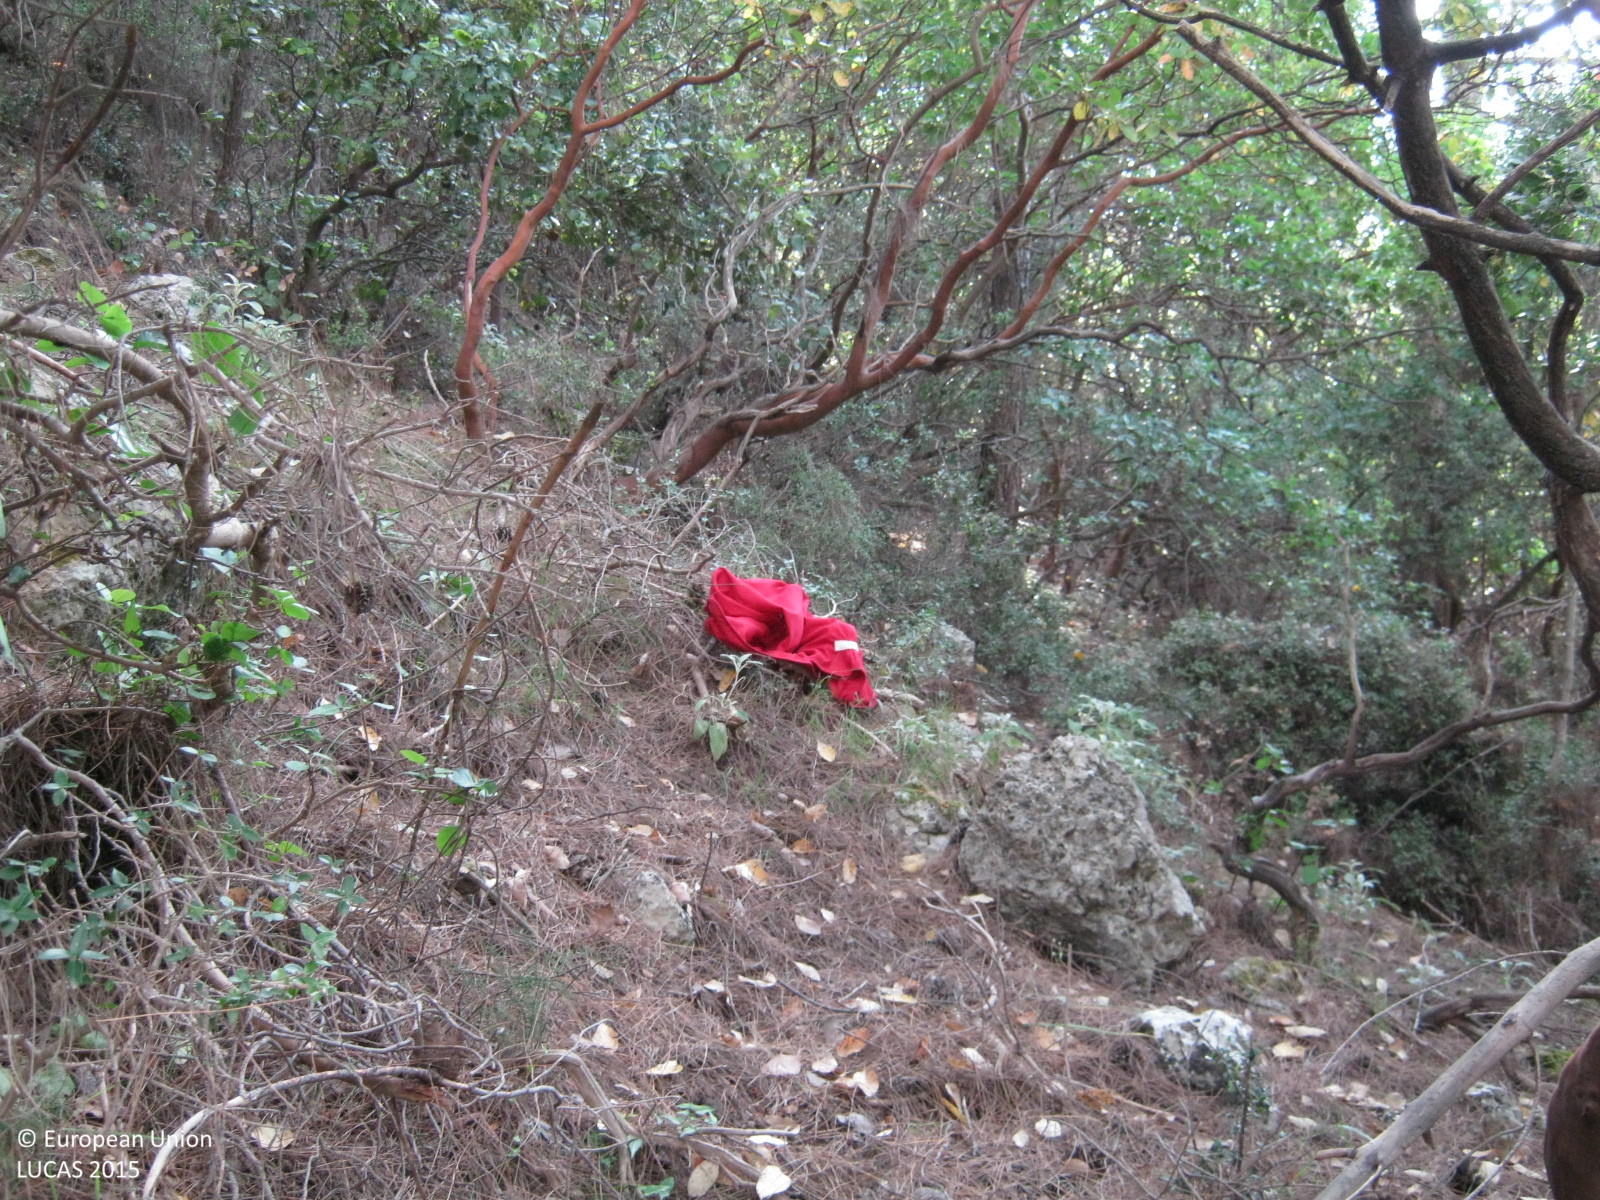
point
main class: Woodland
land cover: Other mixed woodland
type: coniferous forest of the mediterranean region
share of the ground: > 75 %
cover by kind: coniferous forest trees 55 %, broadleaved forest trees 25 %, shrubs 10 %, herbaceous plants 5 %, unconsolidated bare surface 5 %
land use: Semi-natural and natural areas not in use
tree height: > 5 m
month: June
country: GR
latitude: 35.3469
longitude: 23.7461
